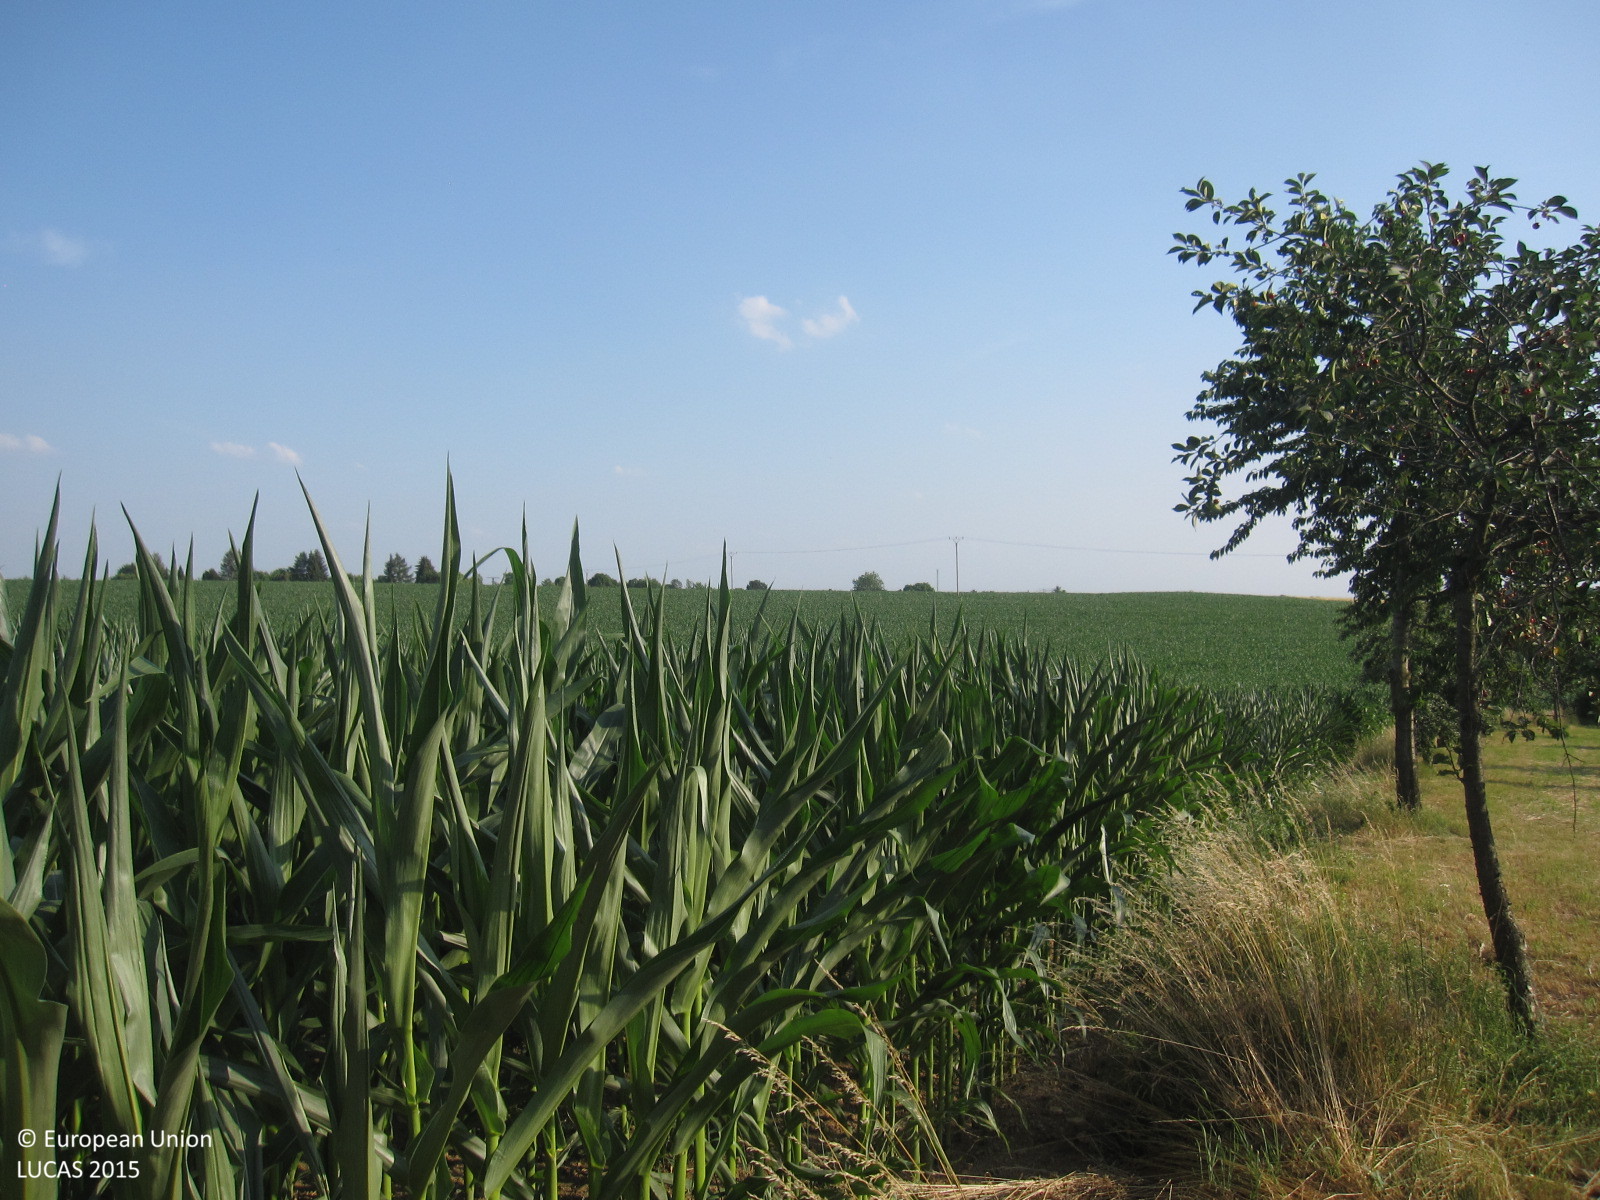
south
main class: Cropland
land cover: Maize
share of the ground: > 75 %
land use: Agriculture (excluding fallow land and kitchen gardens)
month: July
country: DE
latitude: 50.8661
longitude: 12.1168
